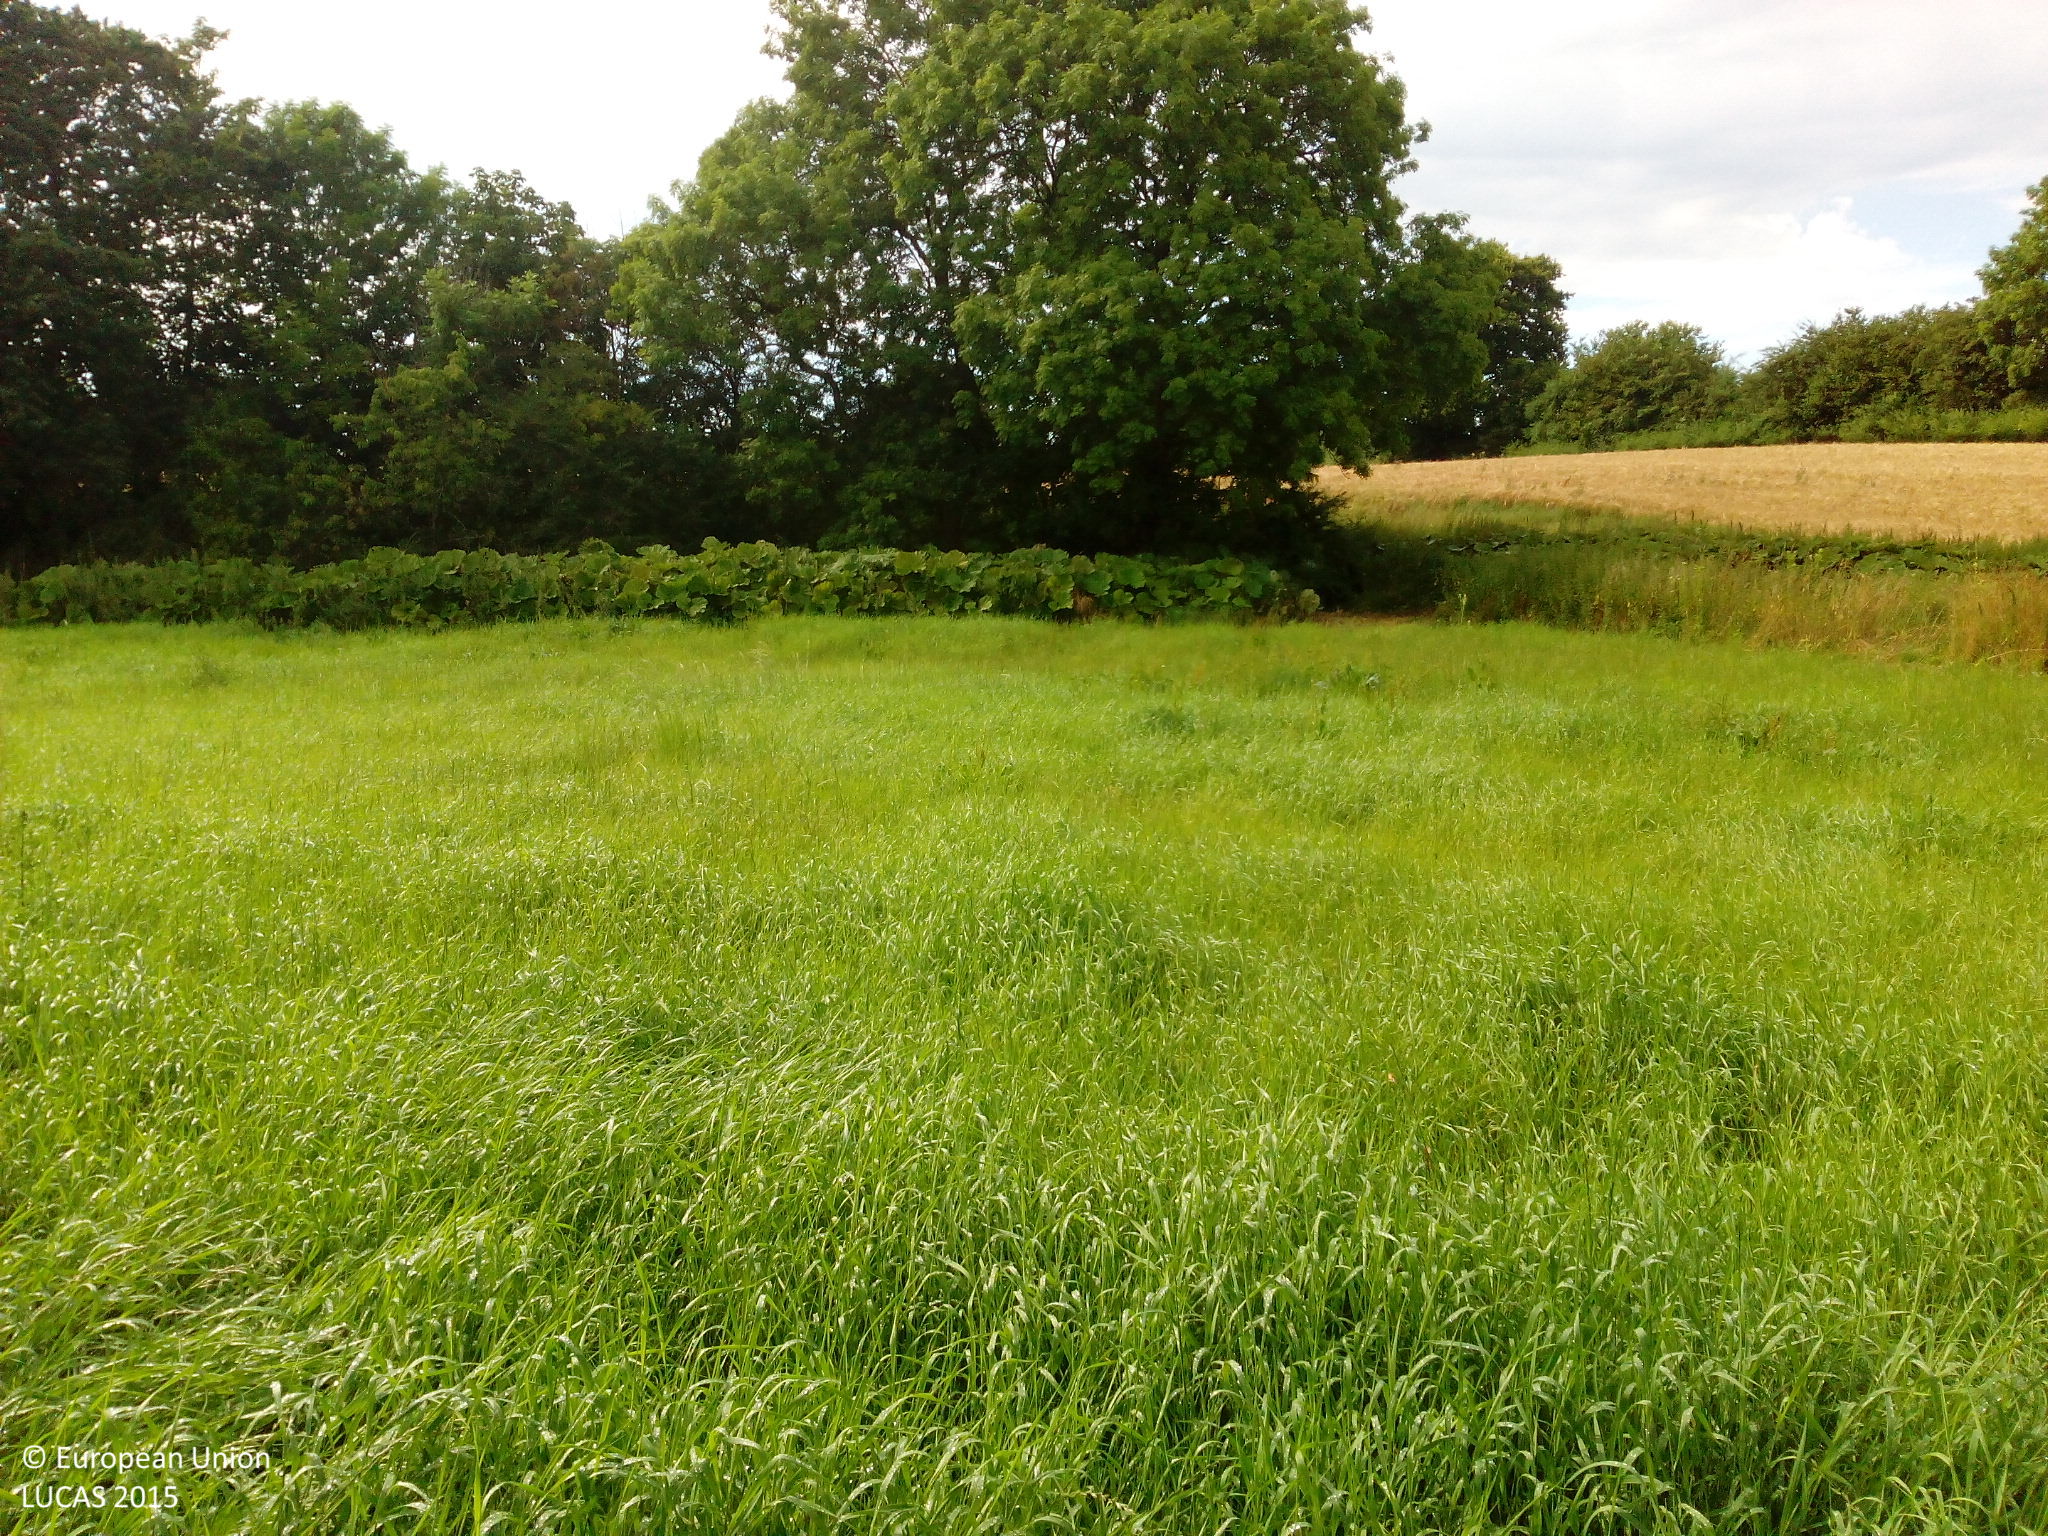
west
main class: Grassland
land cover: Grassland without tree/shrub cover
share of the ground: > 75 %
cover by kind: herbaceous plants 100 %
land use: Agriculture (excluding fallow land and kitchen gardens)
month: August
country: DK
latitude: 55.5285
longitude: 11.7570
